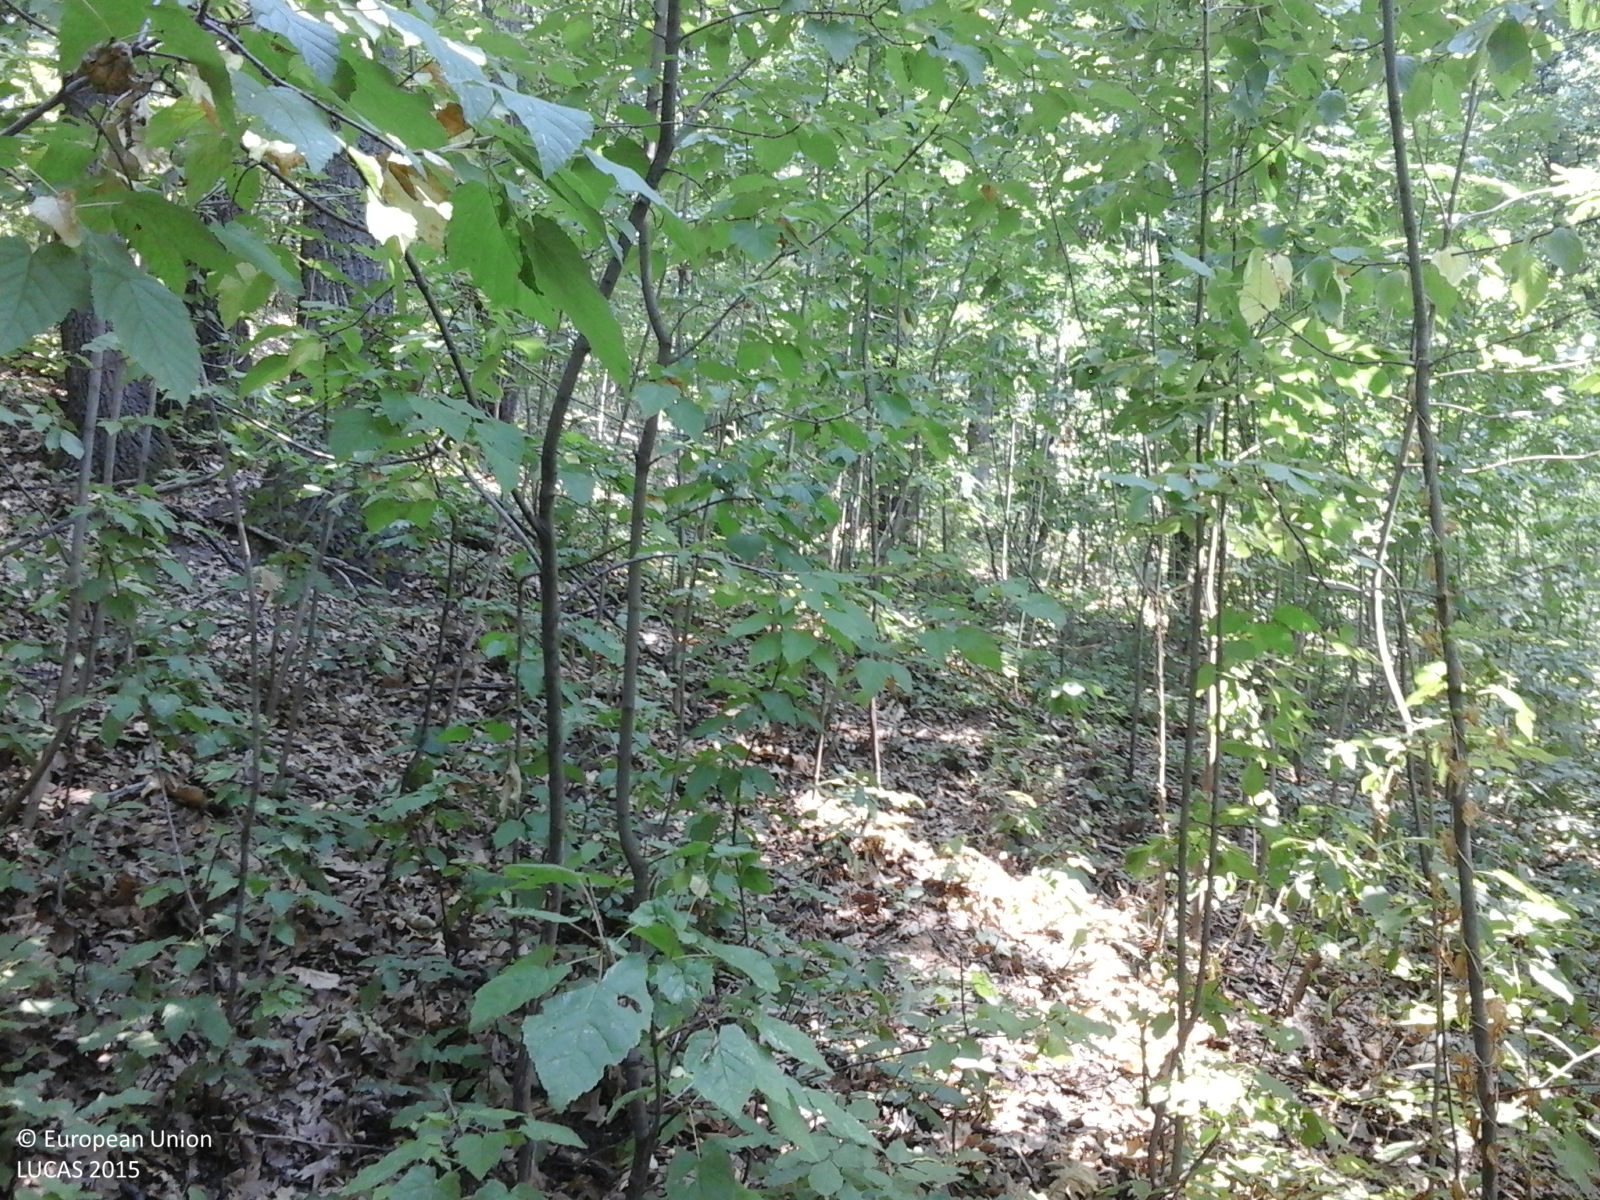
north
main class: Woodland
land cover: Broadleaved woodland
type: acidophilous oak and oak-birch forest
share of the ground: > 75 %
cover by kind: broadleaved forest trees 100 %
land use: Forestry
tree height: > 5 m
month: August
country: RO
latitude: 44.5415
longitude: 23.0733
